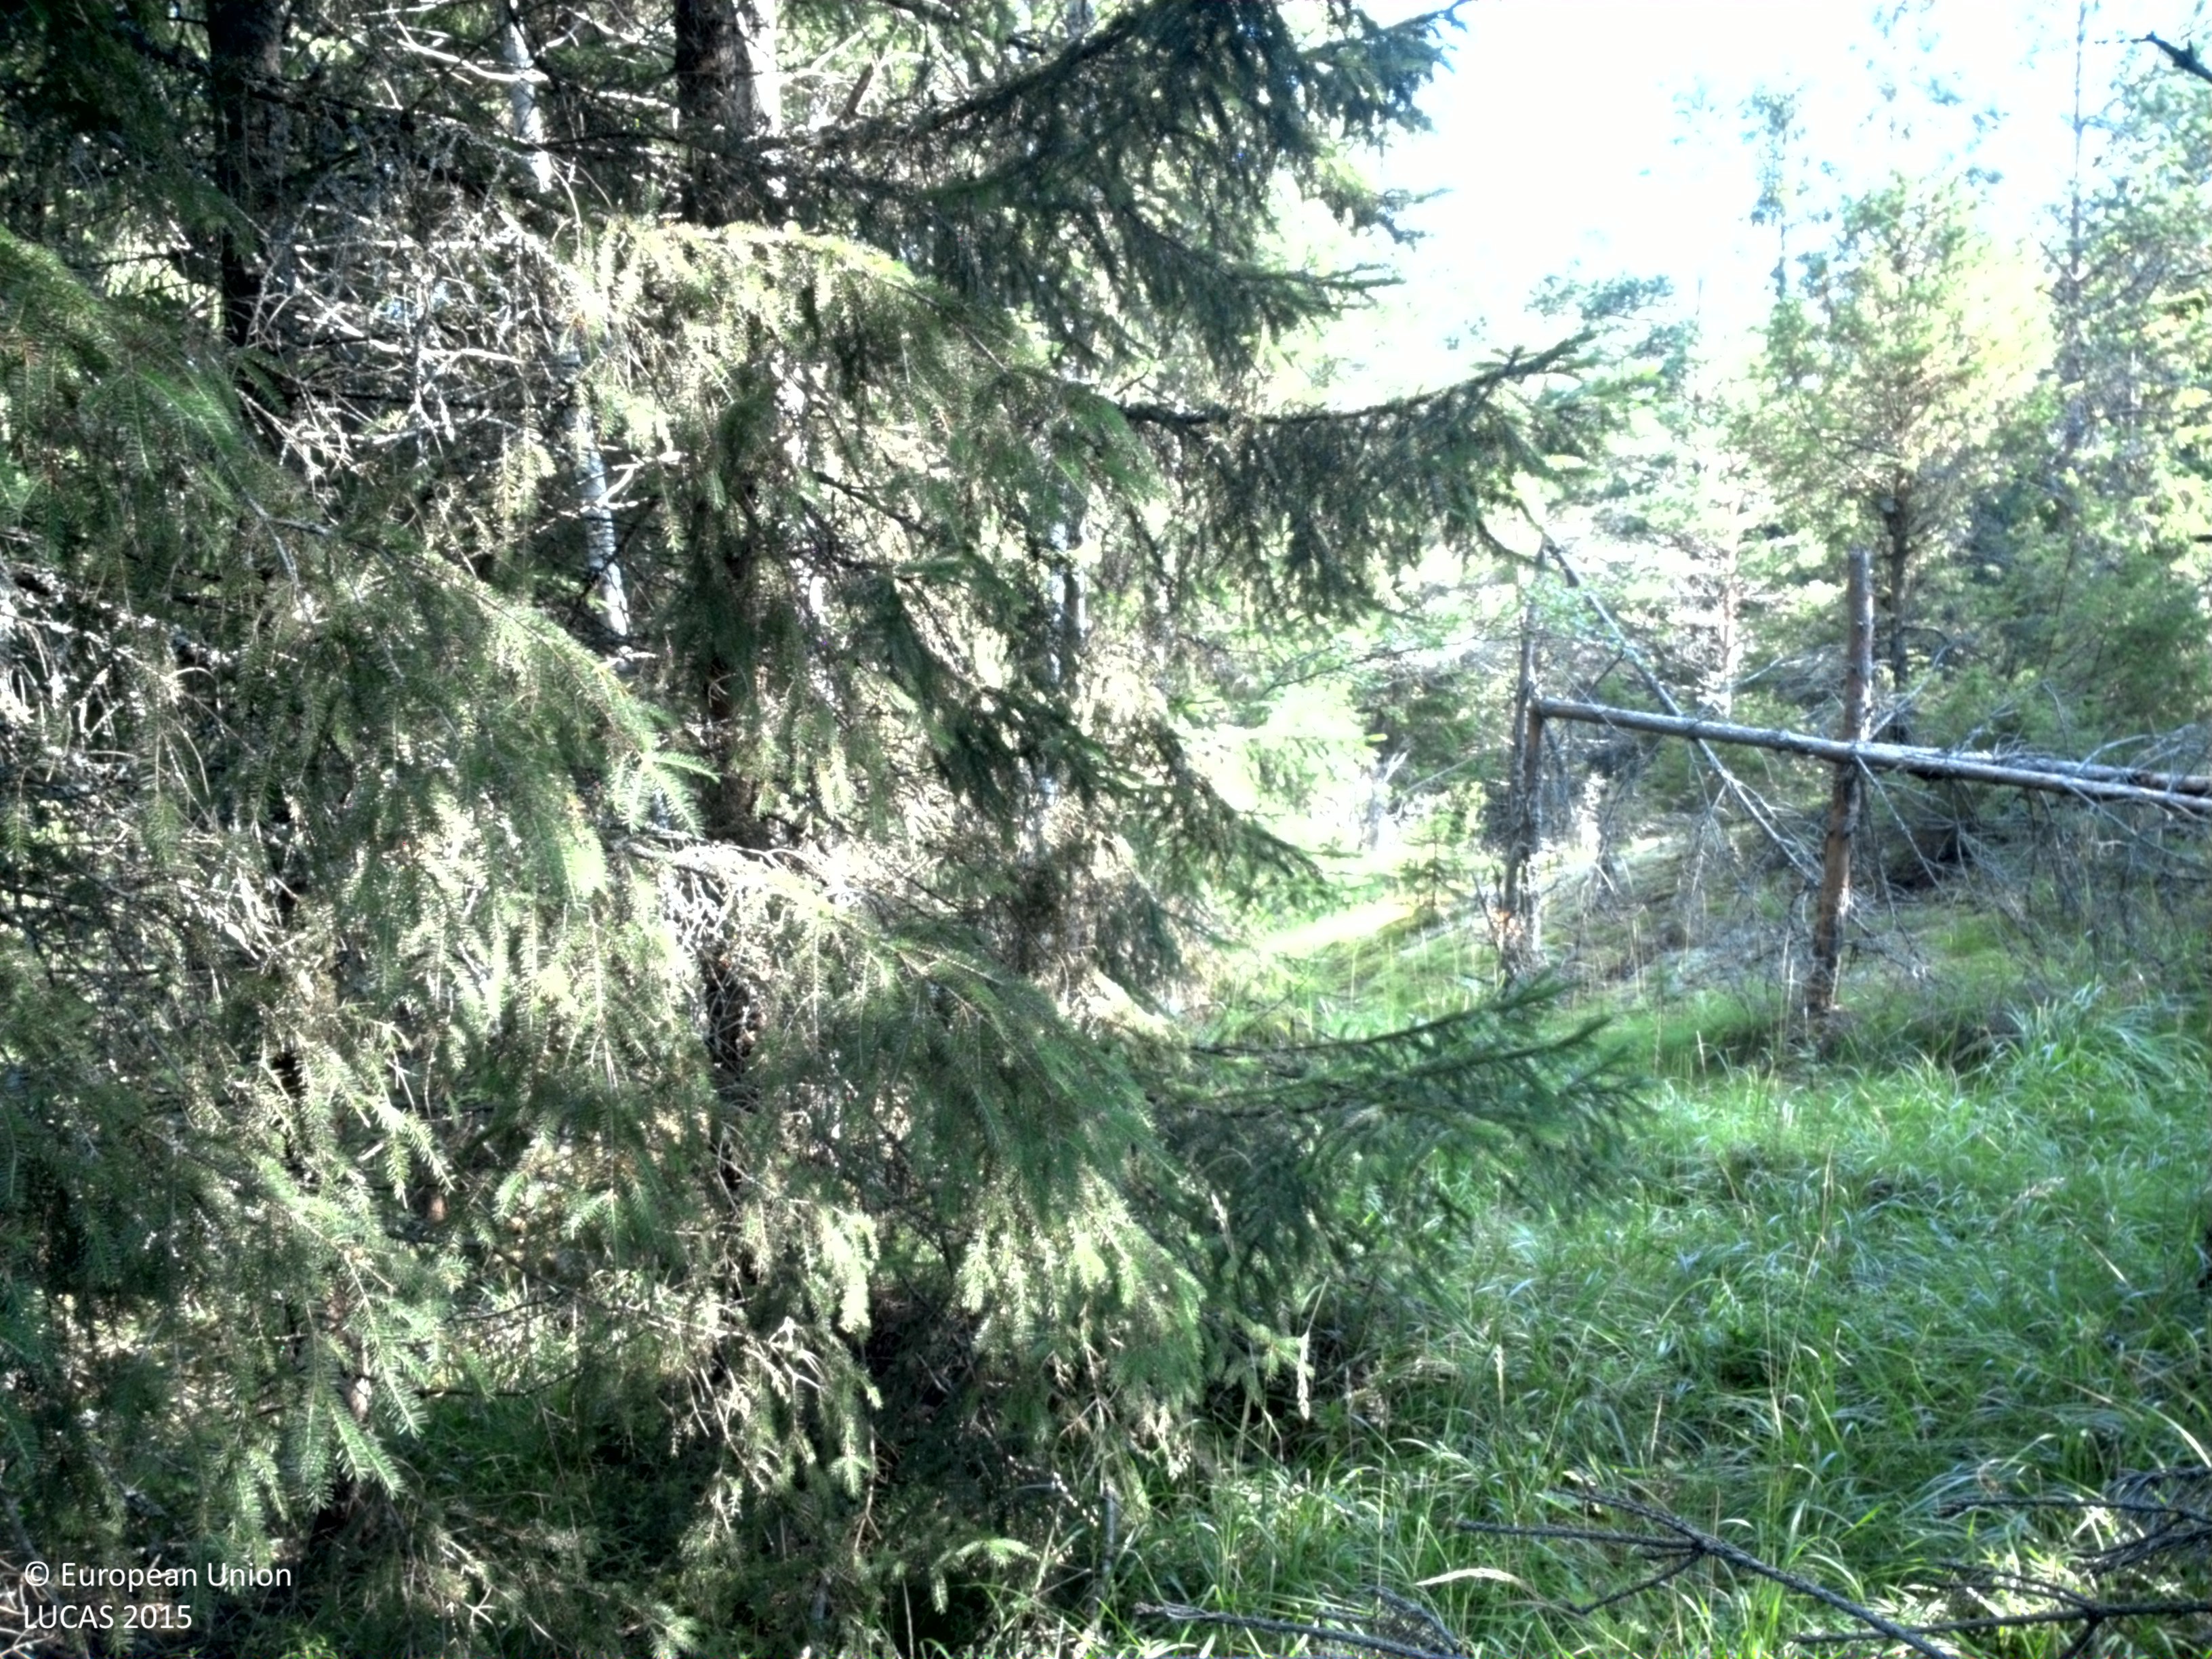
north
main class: Woodland
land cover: Spruce dominated coniferous woodland
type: boreal forest
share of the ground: 50 - 75 %
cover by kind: coniferous forest trees 65 %, lichens and mosses 25 %, broadleaved forest trees 10 %
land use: Forestry
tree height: > 5 m
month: July
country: SE
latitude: 59.7193
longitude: 18.5872
